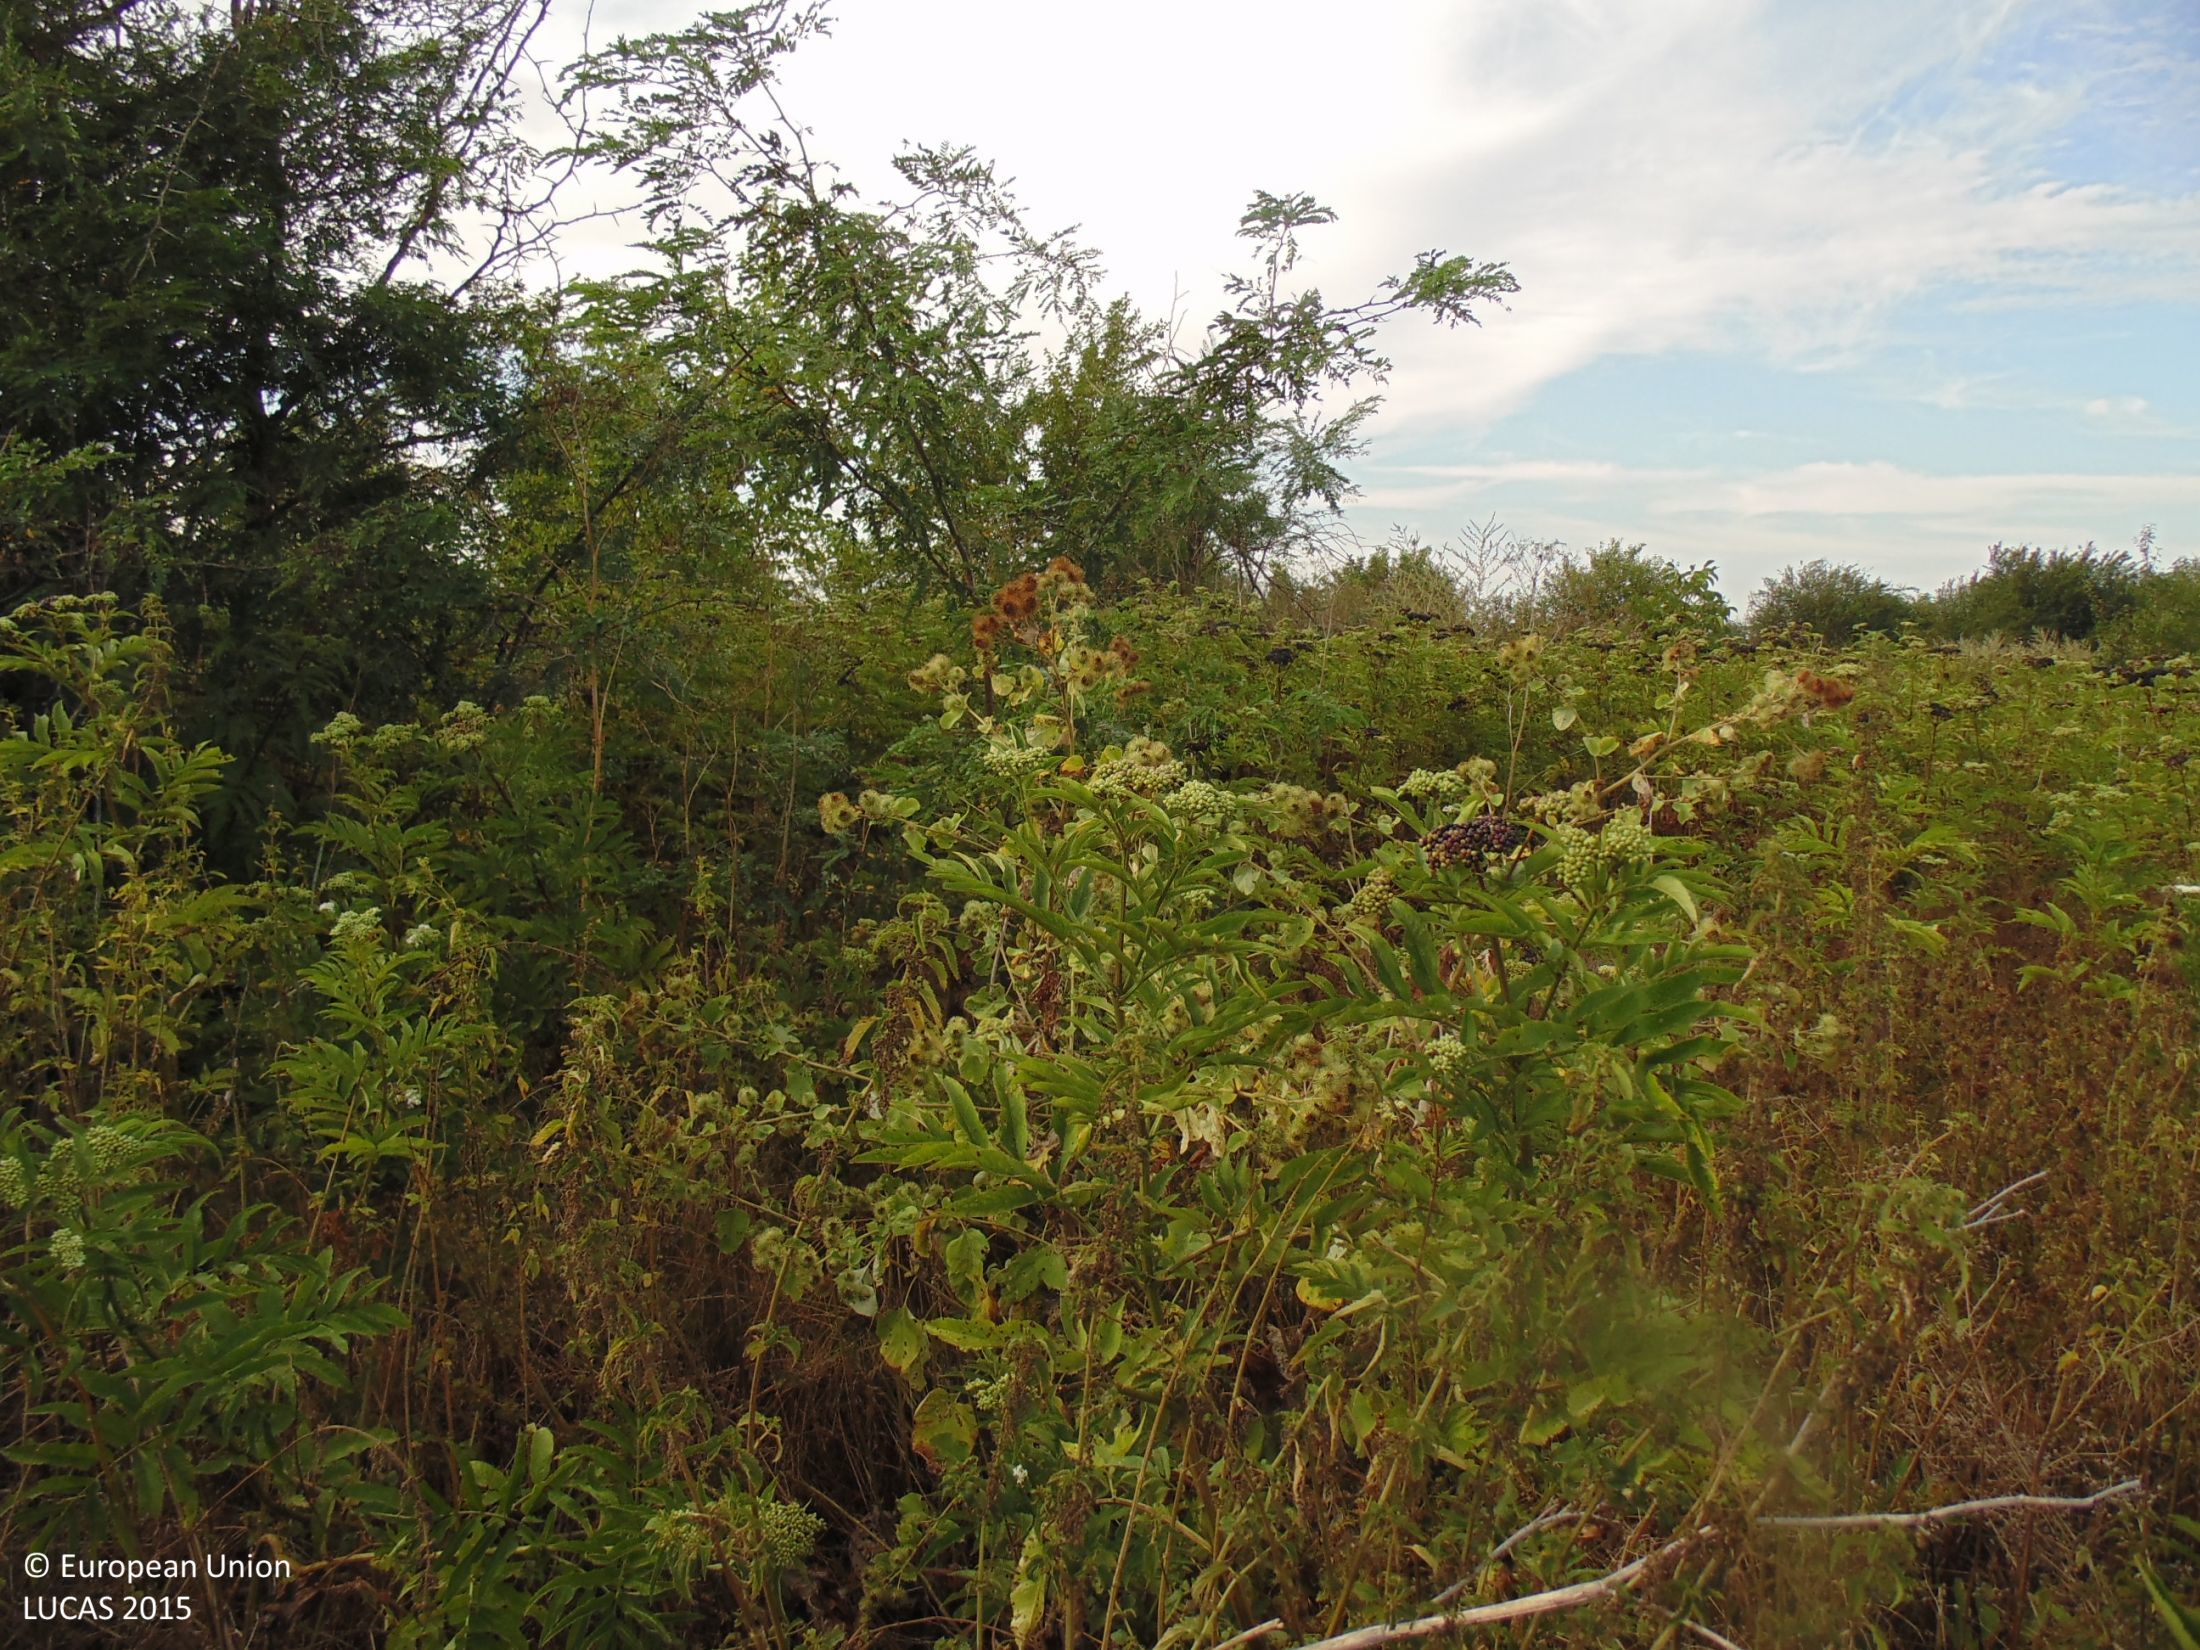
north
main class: Grassland
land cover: Grassland with sparse tree/shrub cover
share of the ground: > 75 %
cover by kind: herbaceous plants 90 %, broadleaved forest trees 5 %, shrubs 5 %
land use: Abandoned areas
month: August
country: BG
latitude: 43.5961
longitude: 28.2777
